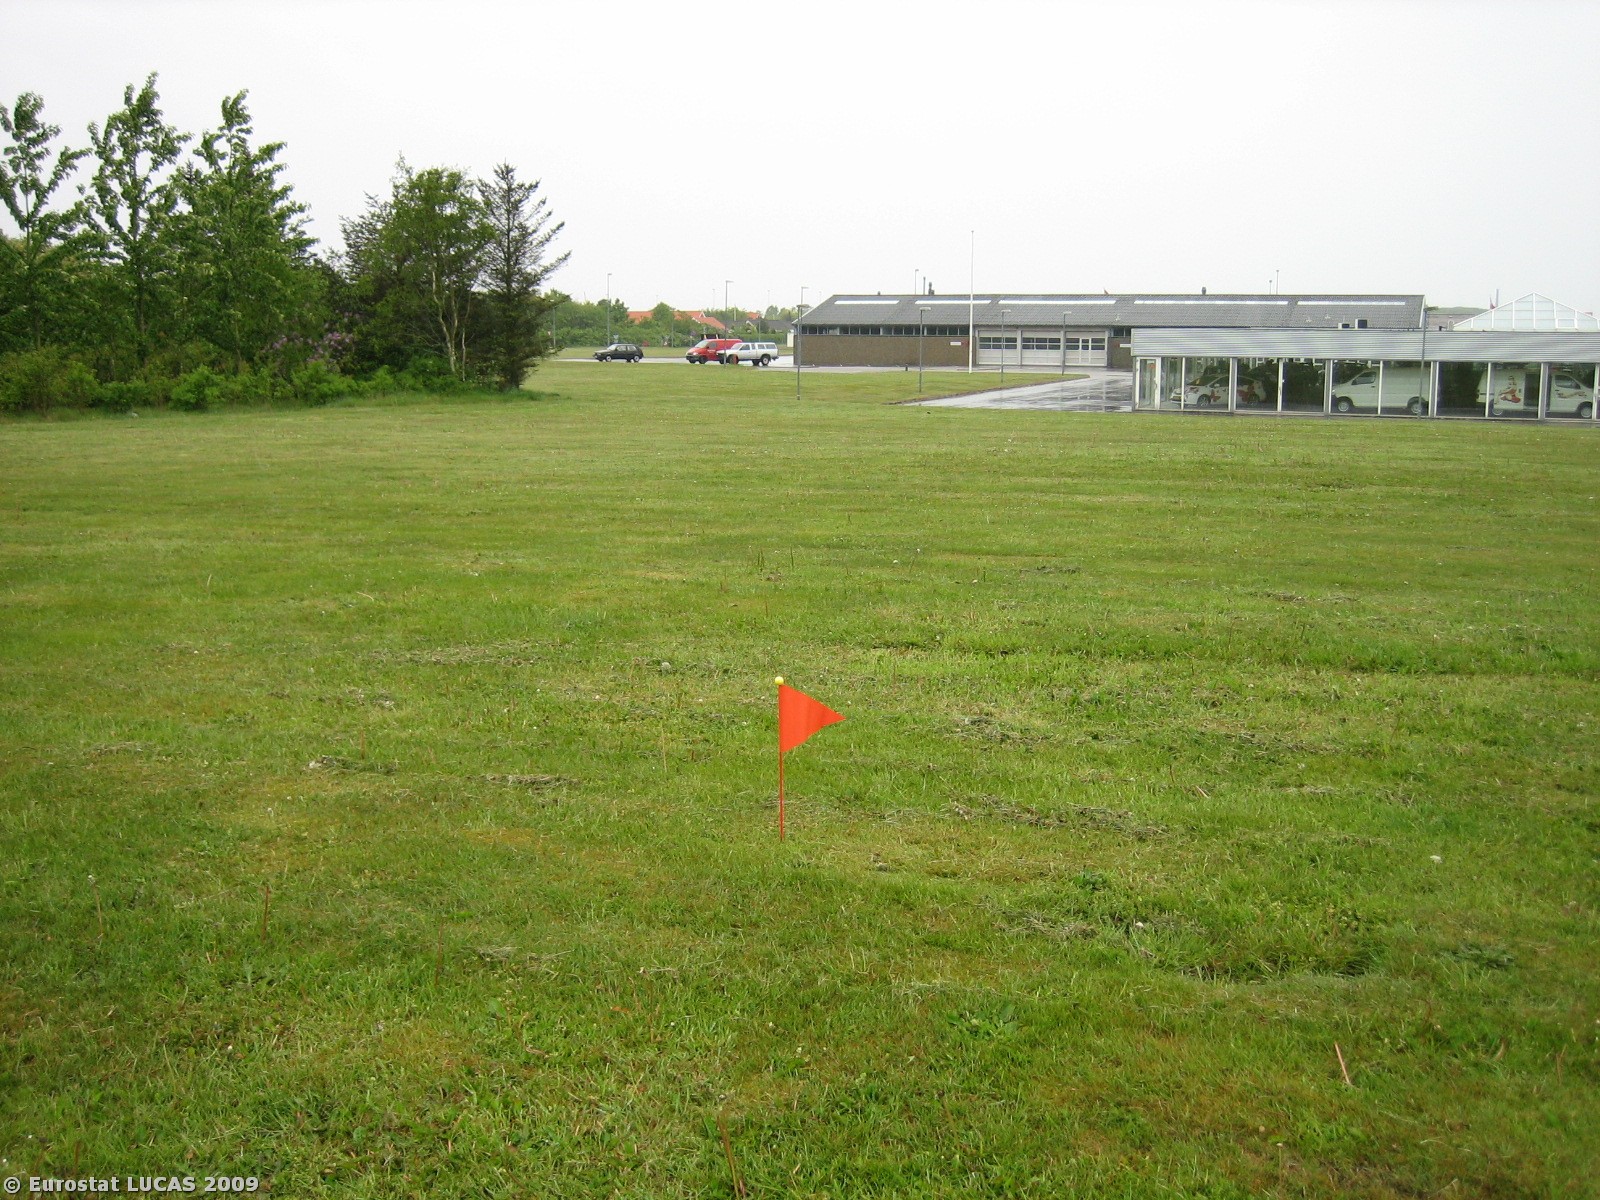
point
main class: Grassland
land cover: Grassland without tree/shrub cover
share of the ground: > 75 %
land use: Commerce, finance, business
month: May
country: DK
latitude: 56.0864
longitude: 8.2823
